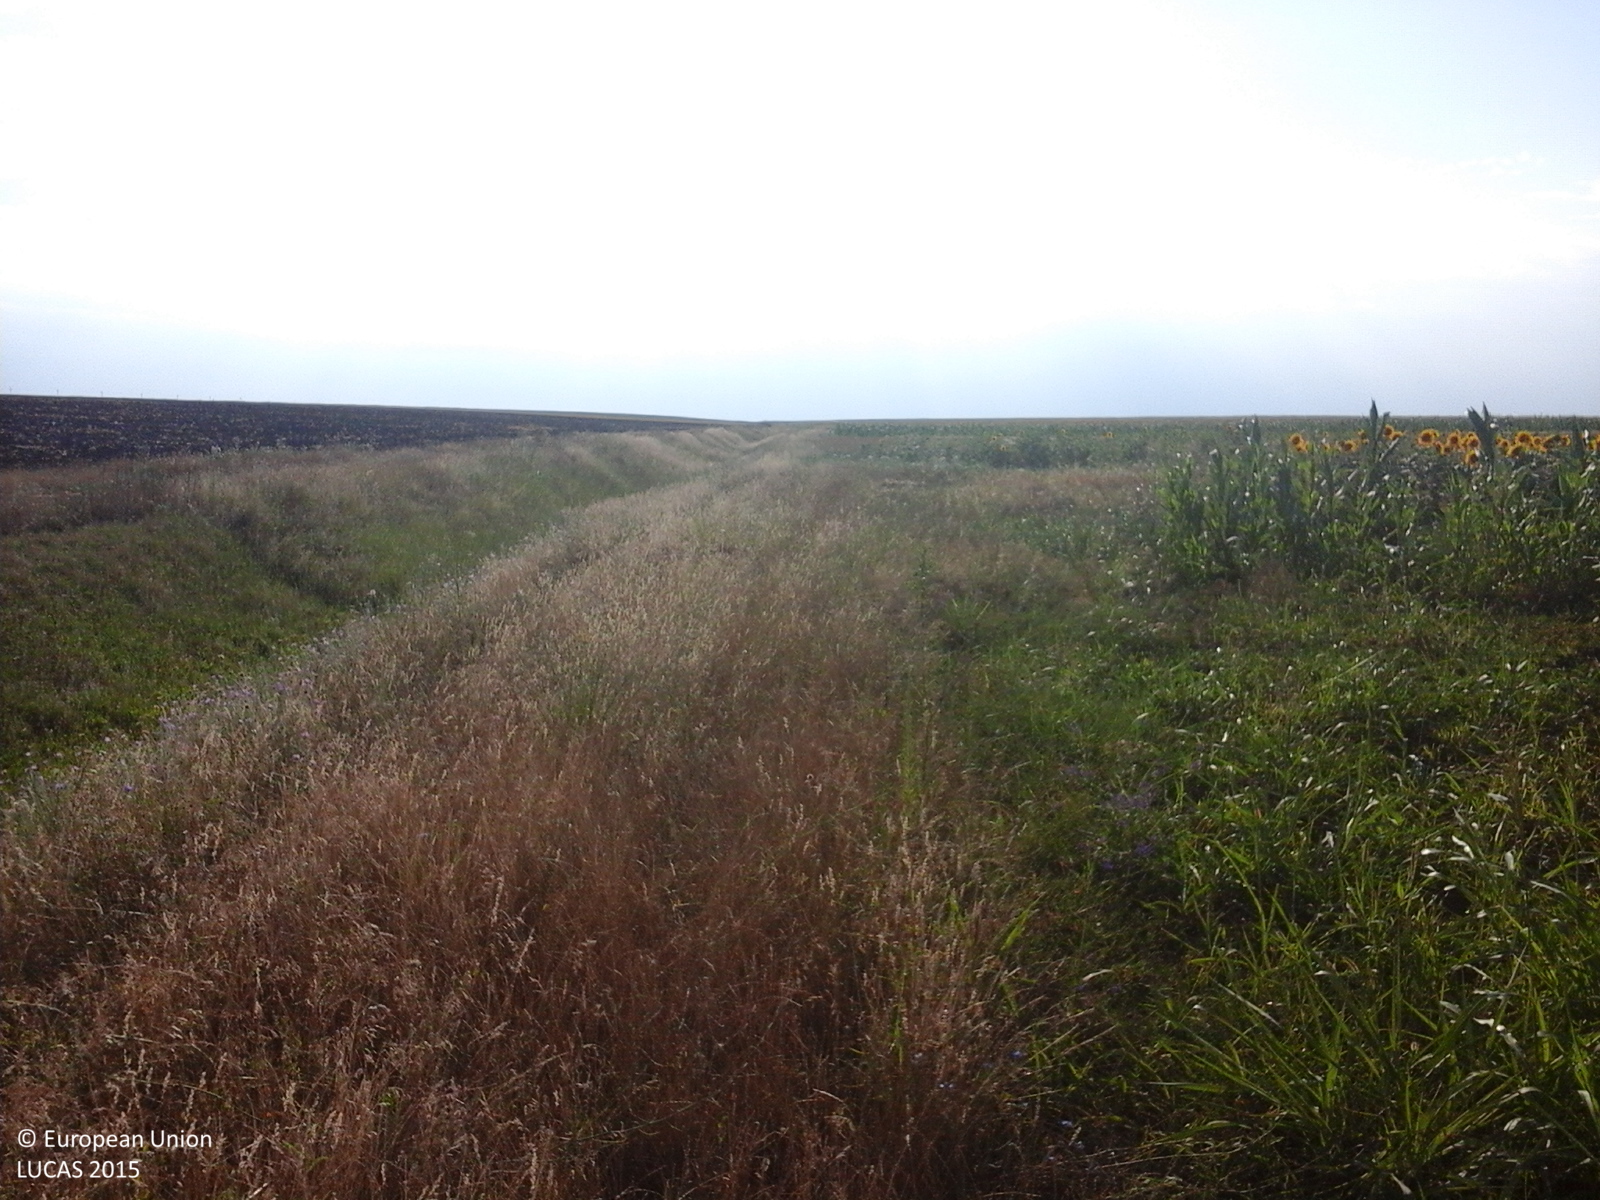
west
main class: Cropland
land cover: Sunflower
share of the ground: > 75 %
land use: Agriculture (excluding fallow land and kitchen gardens)
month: July
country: RO
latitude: 43.8299
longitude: 24.2997
